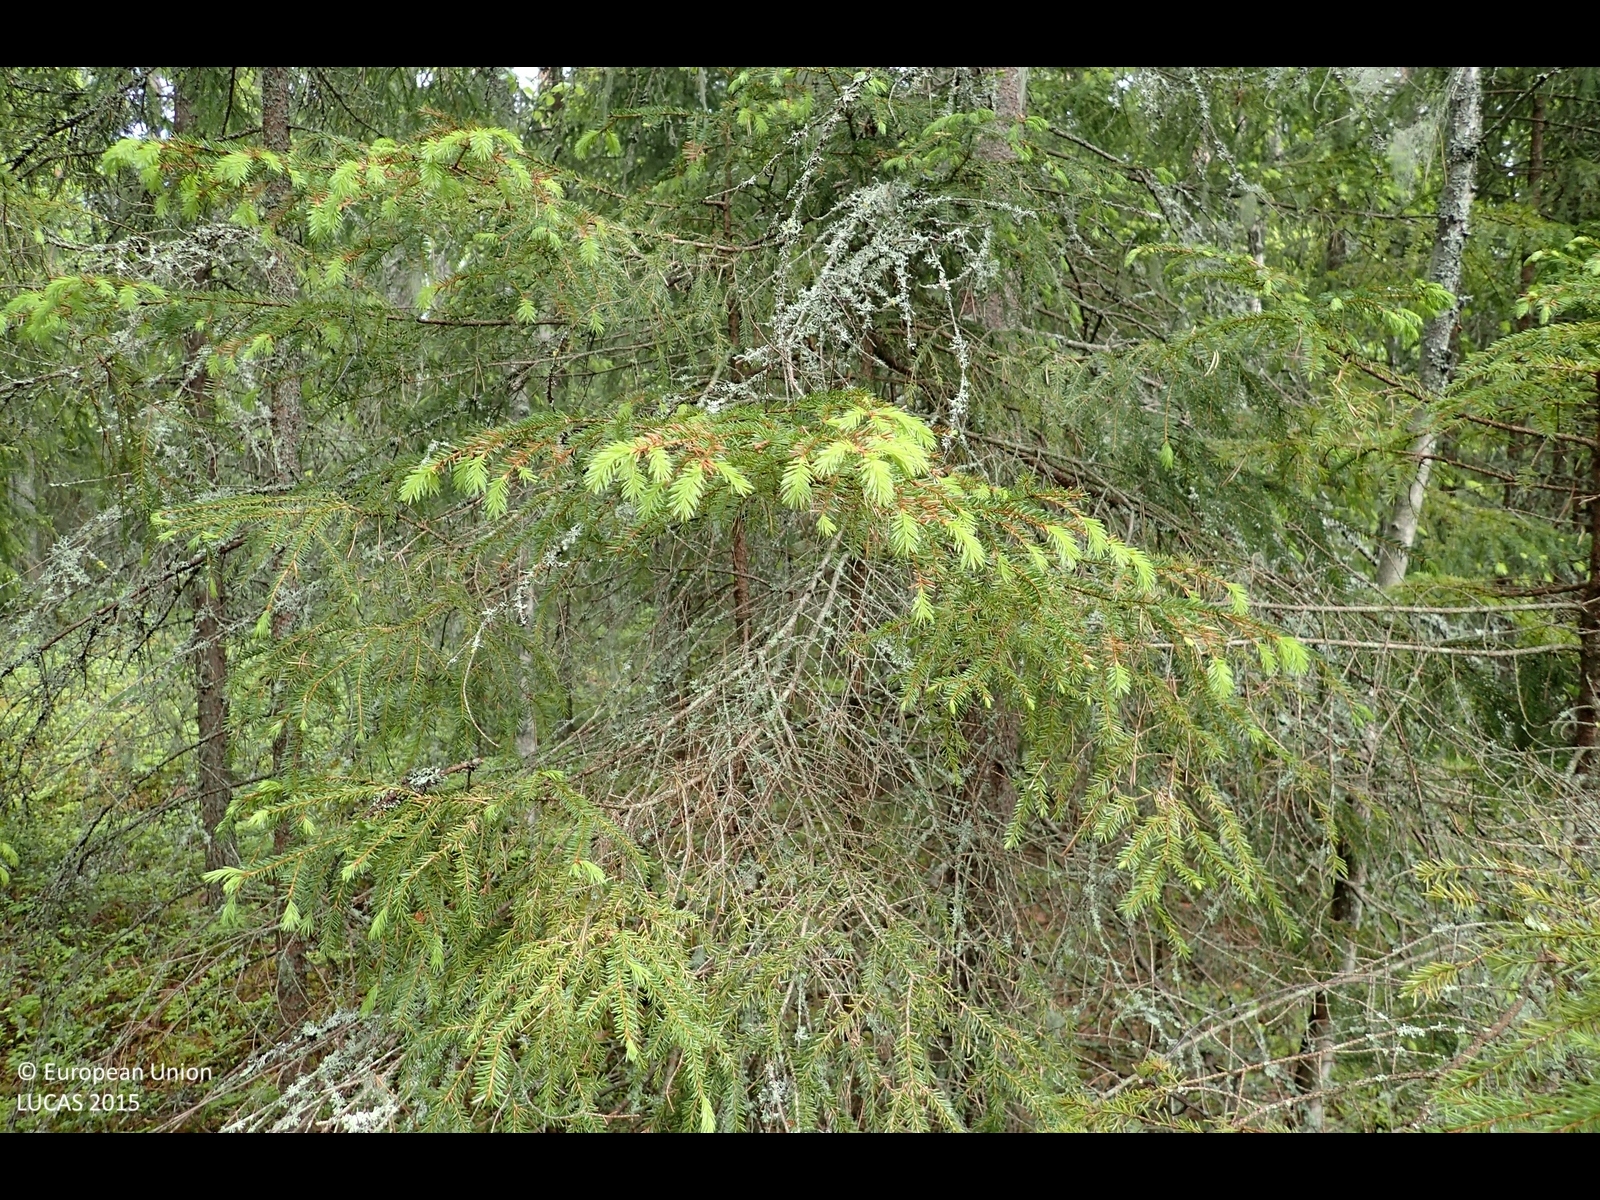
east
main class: Woodland
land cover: Pine dominated coniferous woodland
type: boreal forest
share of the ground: > 75 %
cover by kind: coniferous forest trees 75 %, shrubs 20 %, broadleaved forest trees 5 %
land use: Forestry
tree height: > 5 m
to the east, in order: Pine dominated coniferous woodland; Spruce dominated mixed woodland; Ditches and canals; Pine dominated mixed woodland; Pine dominated coniferous woodland; Ditches and canals; Pine dominated coniferous woodland
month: June
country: FI
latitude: 62.3515
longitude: 23.0654
